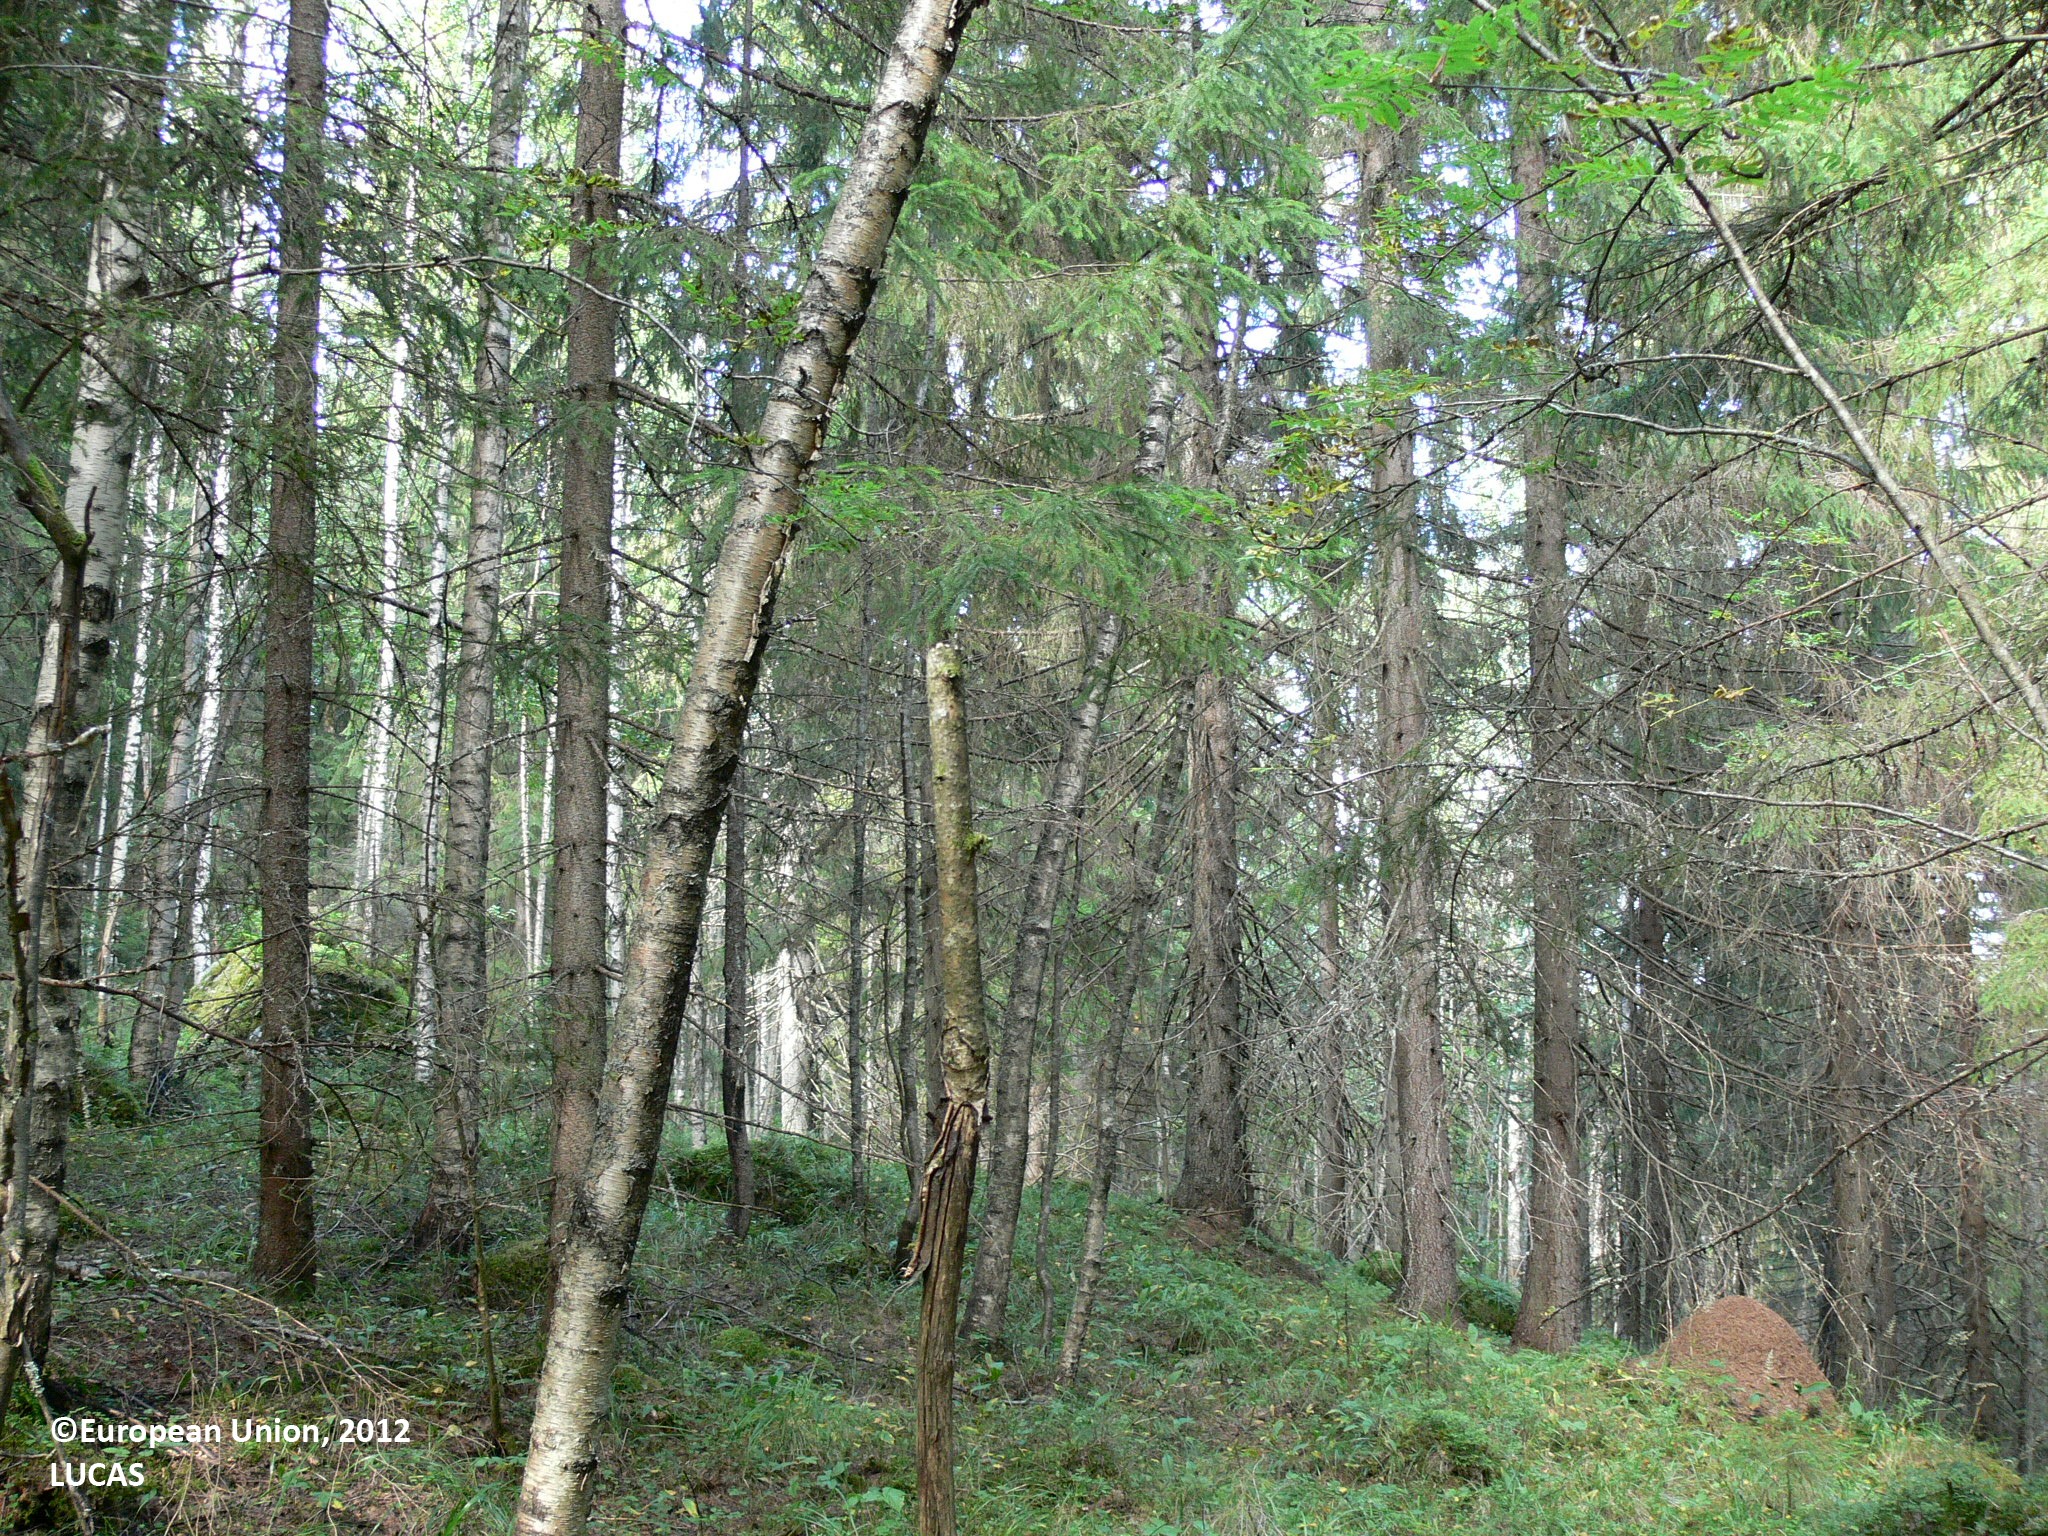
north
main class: Woodland
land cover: Spruce dominated mixed woodland
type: boreal forest
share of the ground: > 75 %
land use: Semi-natural and natural areas not in use
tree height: > 5 m
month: August
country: FI
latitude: 63.0866
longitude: 29.8305
